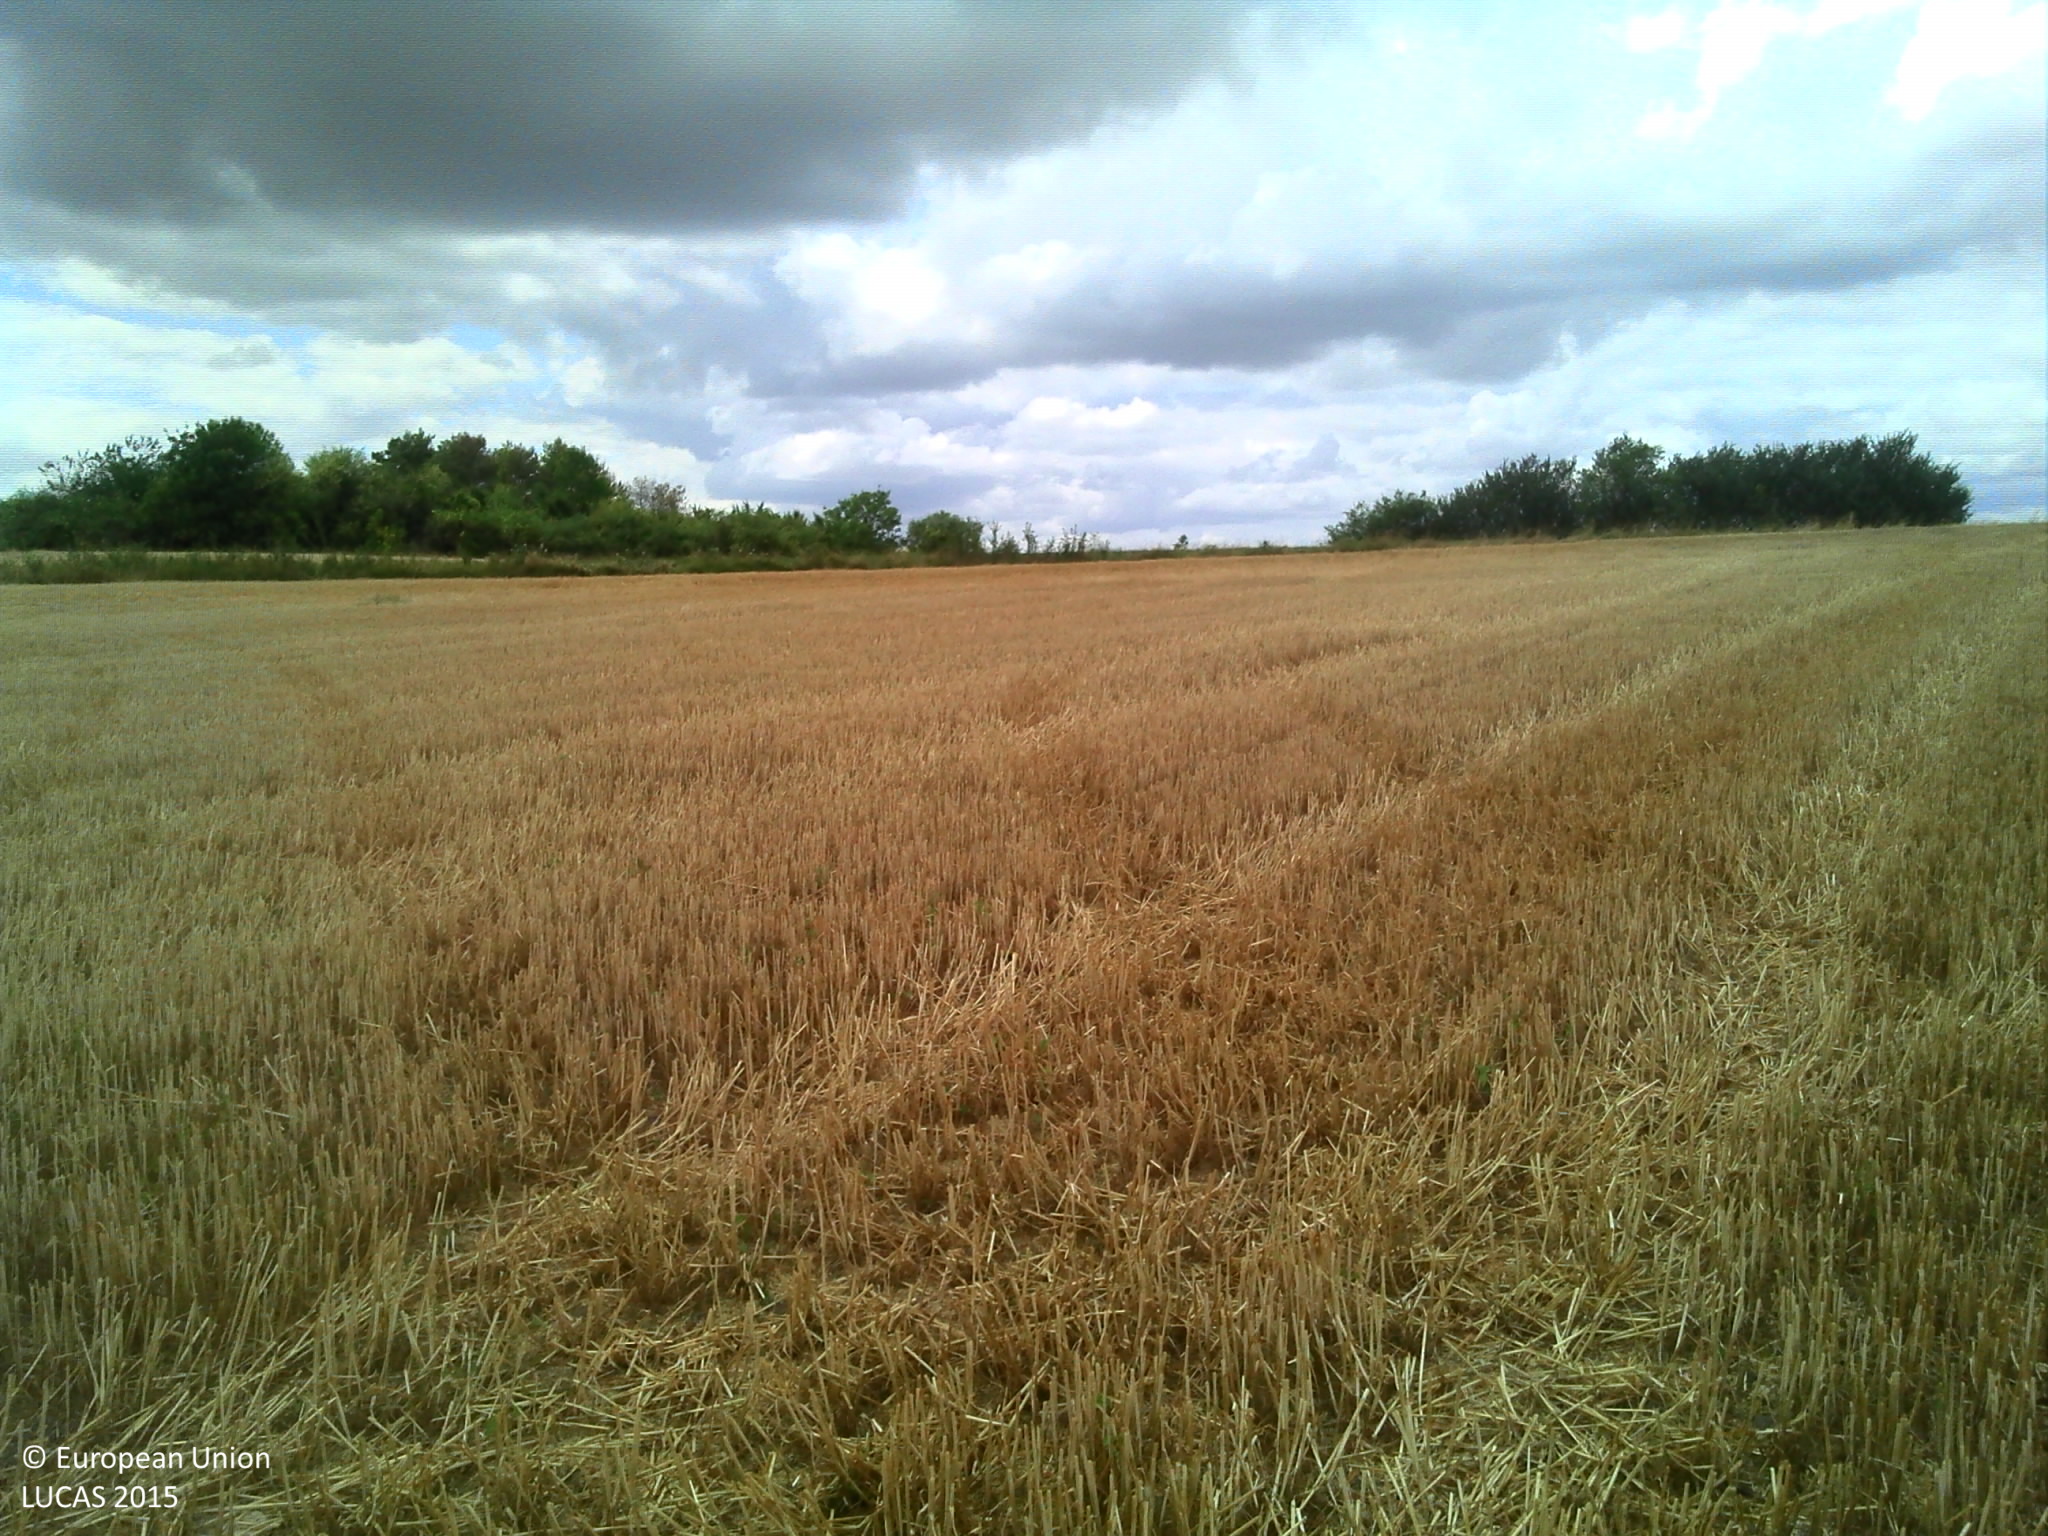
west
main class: Cropland
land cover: Common wheat
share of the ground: > 75 %
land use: Agriculture (excluding fallow land and kitchen gardens)
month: July
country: FR
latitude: 46.9862
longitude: 0.7926
